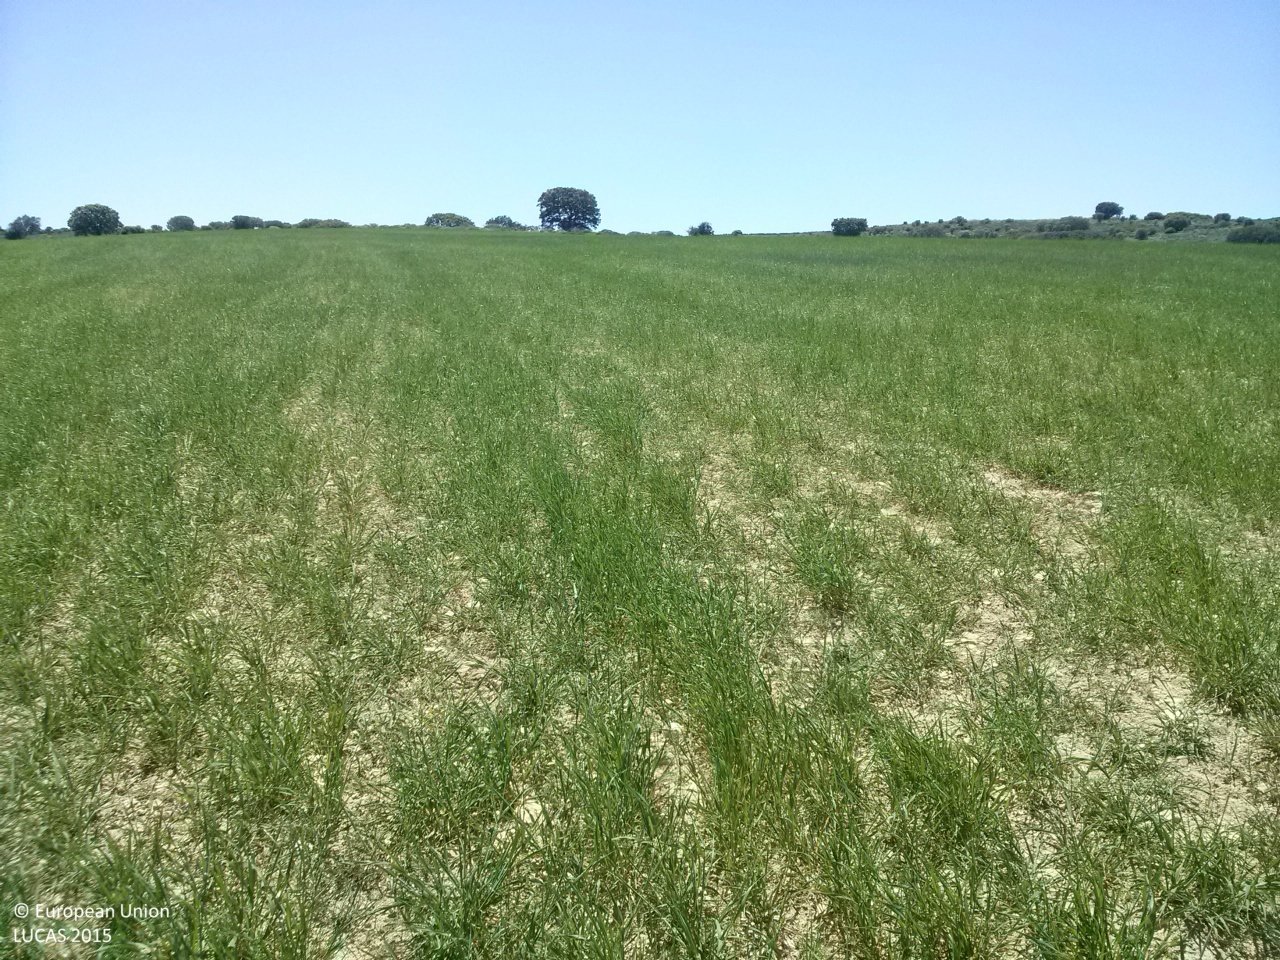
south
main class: Cropland
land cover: Barley
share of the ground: > 75 %
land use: Agriculture (excluding fallow land and kitchen gardens)
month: May
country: ES
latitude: 39.7785
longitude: -2.7563
